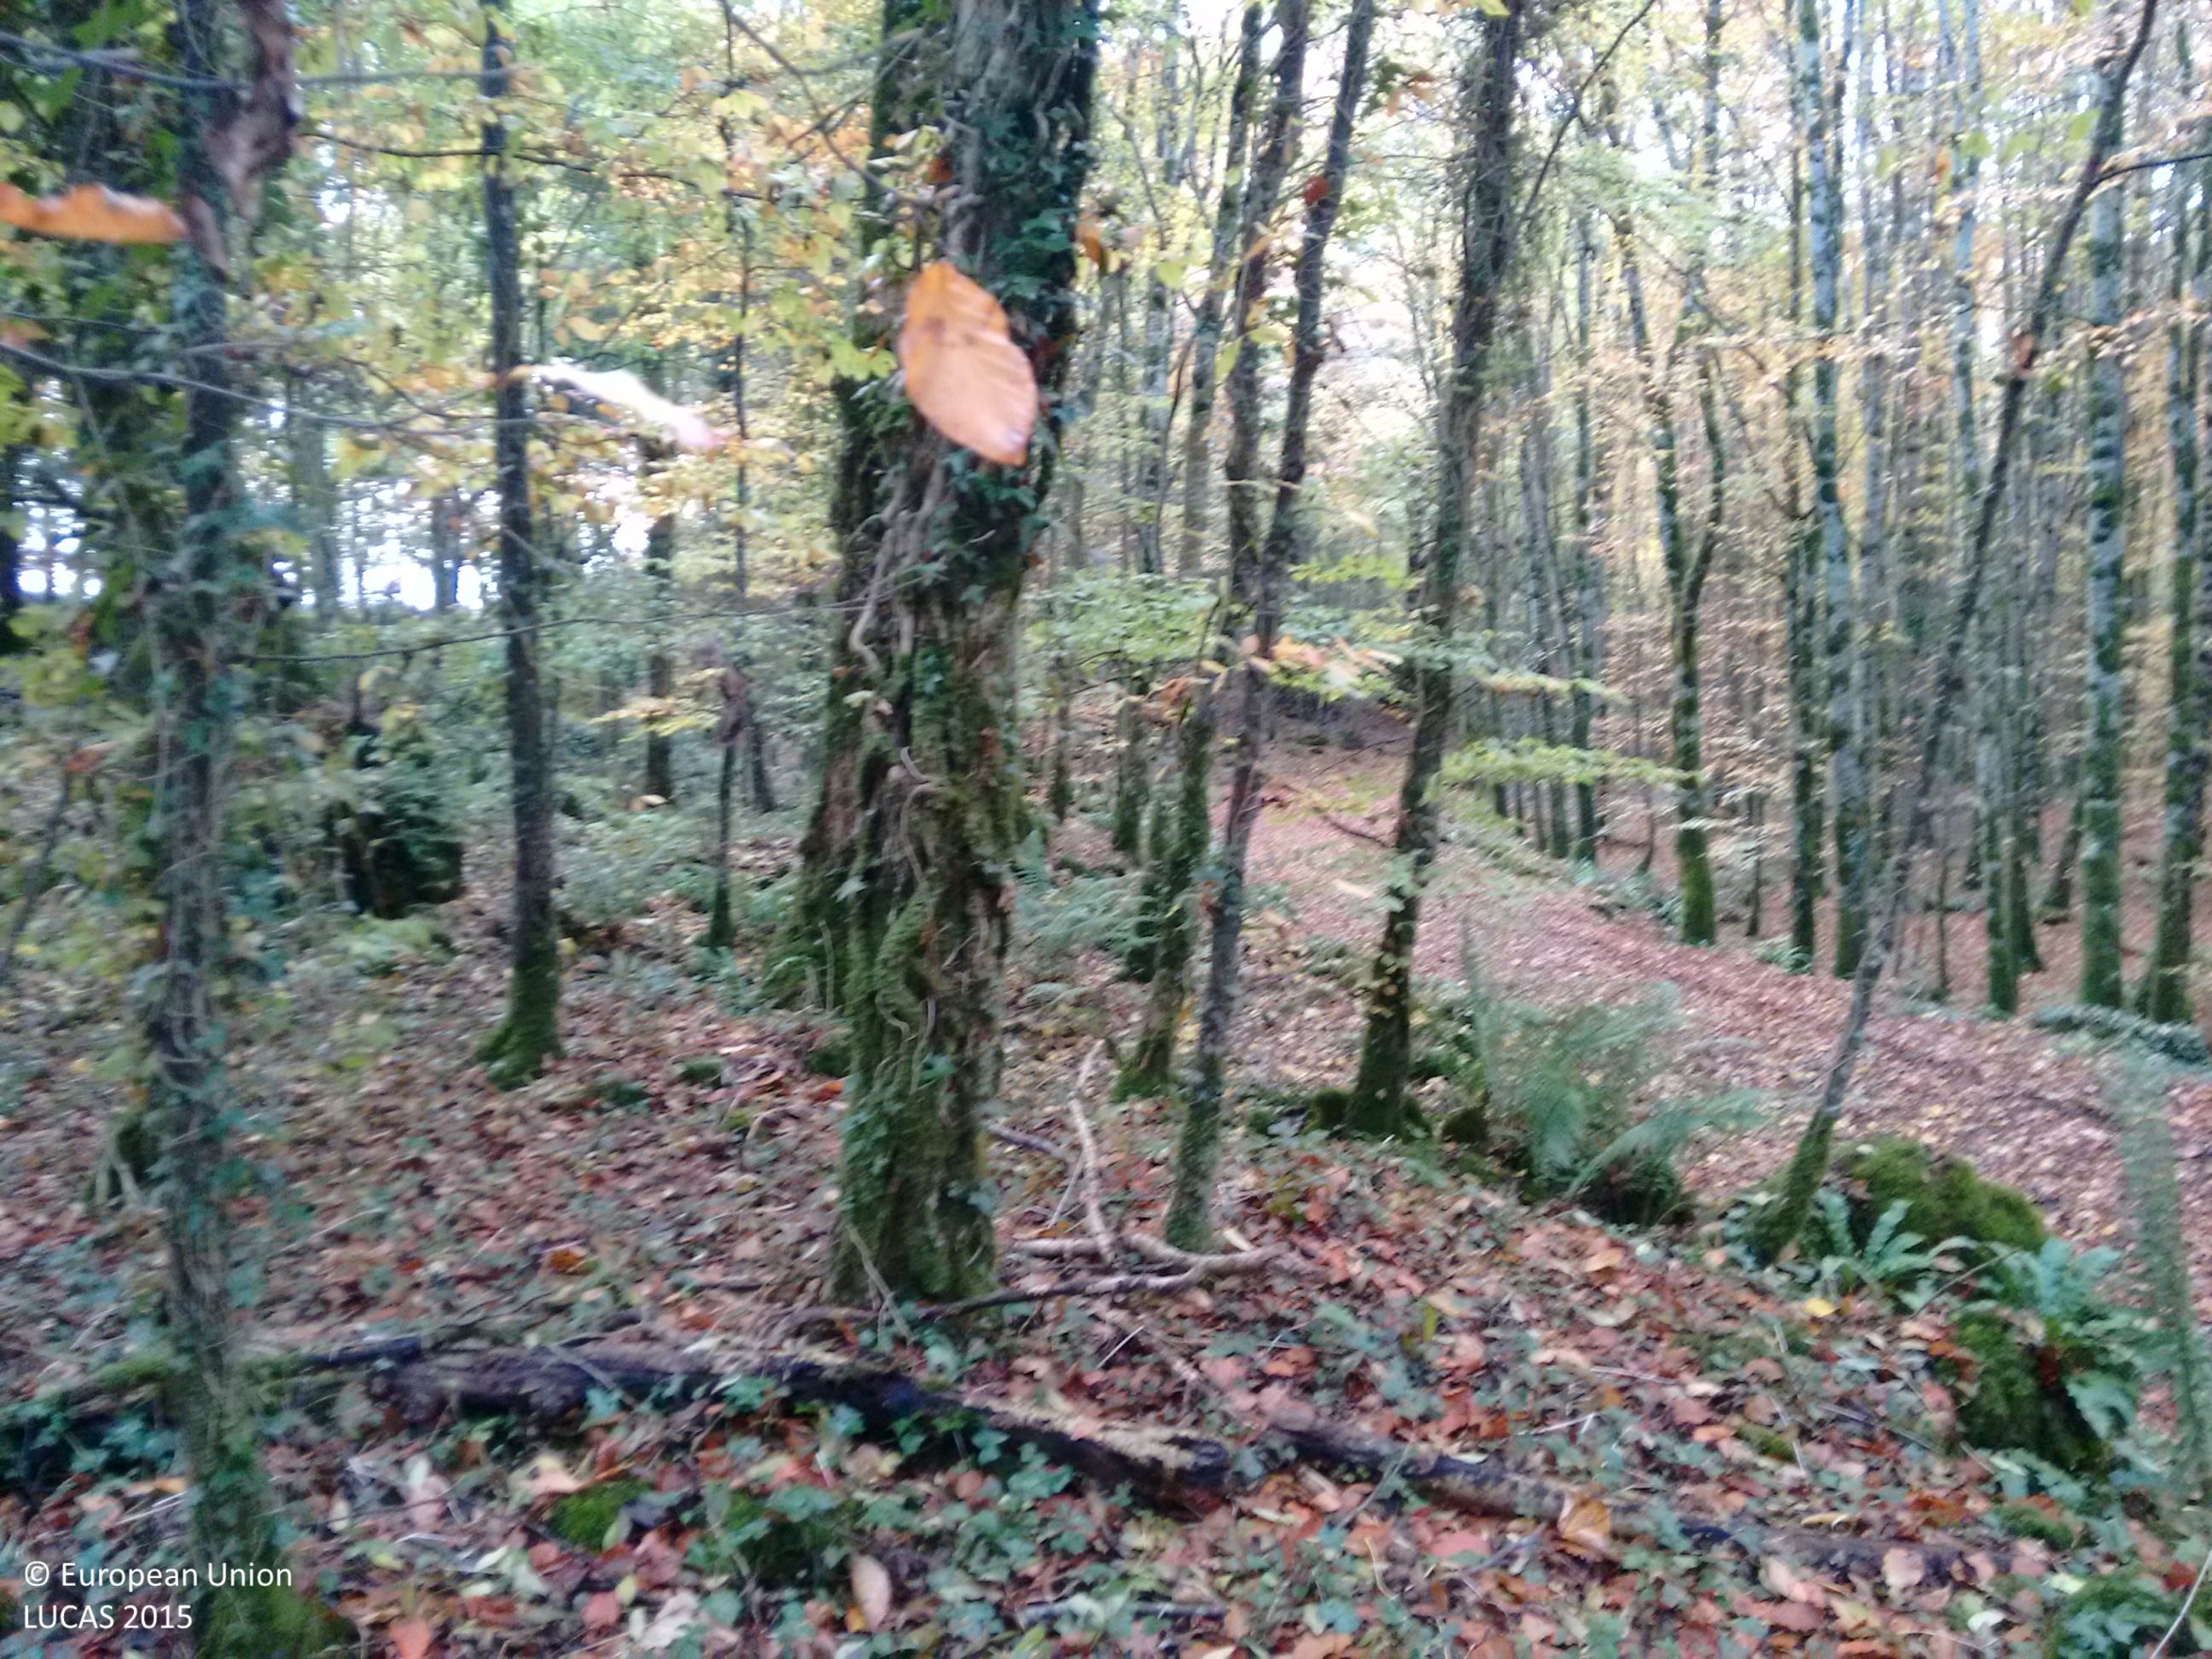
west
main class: Woodland
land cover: Broadleaved woodland
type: acidophilous oak and oak-birch forest
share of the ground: > 75 %
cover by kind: broadleaved forest trees 95 %, herbaceous plants 5 %
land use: Amenities, museums, leisure
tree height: > 5 m
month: October
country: IE
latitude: 53.9738
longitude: -8.2498
